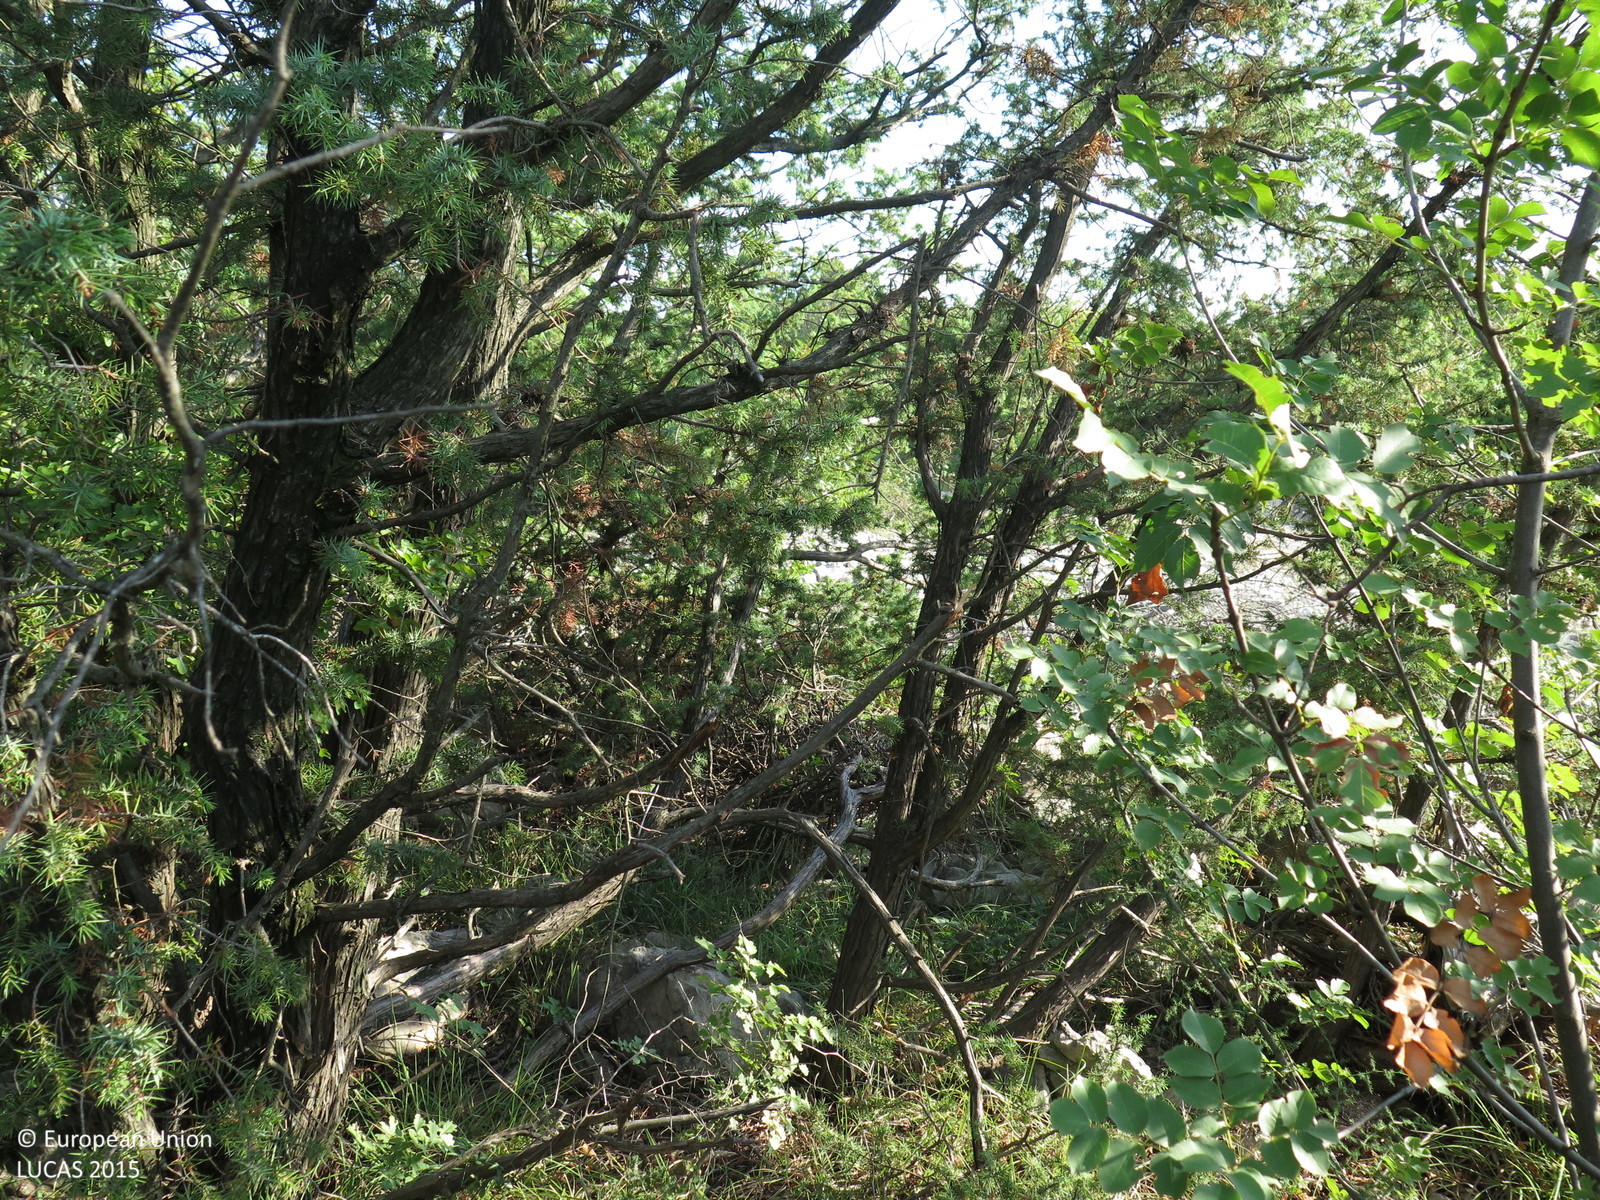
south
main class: Woodland
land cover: Broadleaved woodland
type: thermophilous deciduous forest
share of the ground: > 75 %
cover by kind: broadleaved forest trees 90 %, shrubs 5 %, unconsolidated bare surface 5 %
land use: Semi-natural and natural areas not in use
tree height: < 5 m
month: August
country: HR
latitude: 45.0408
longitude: 14.6534
